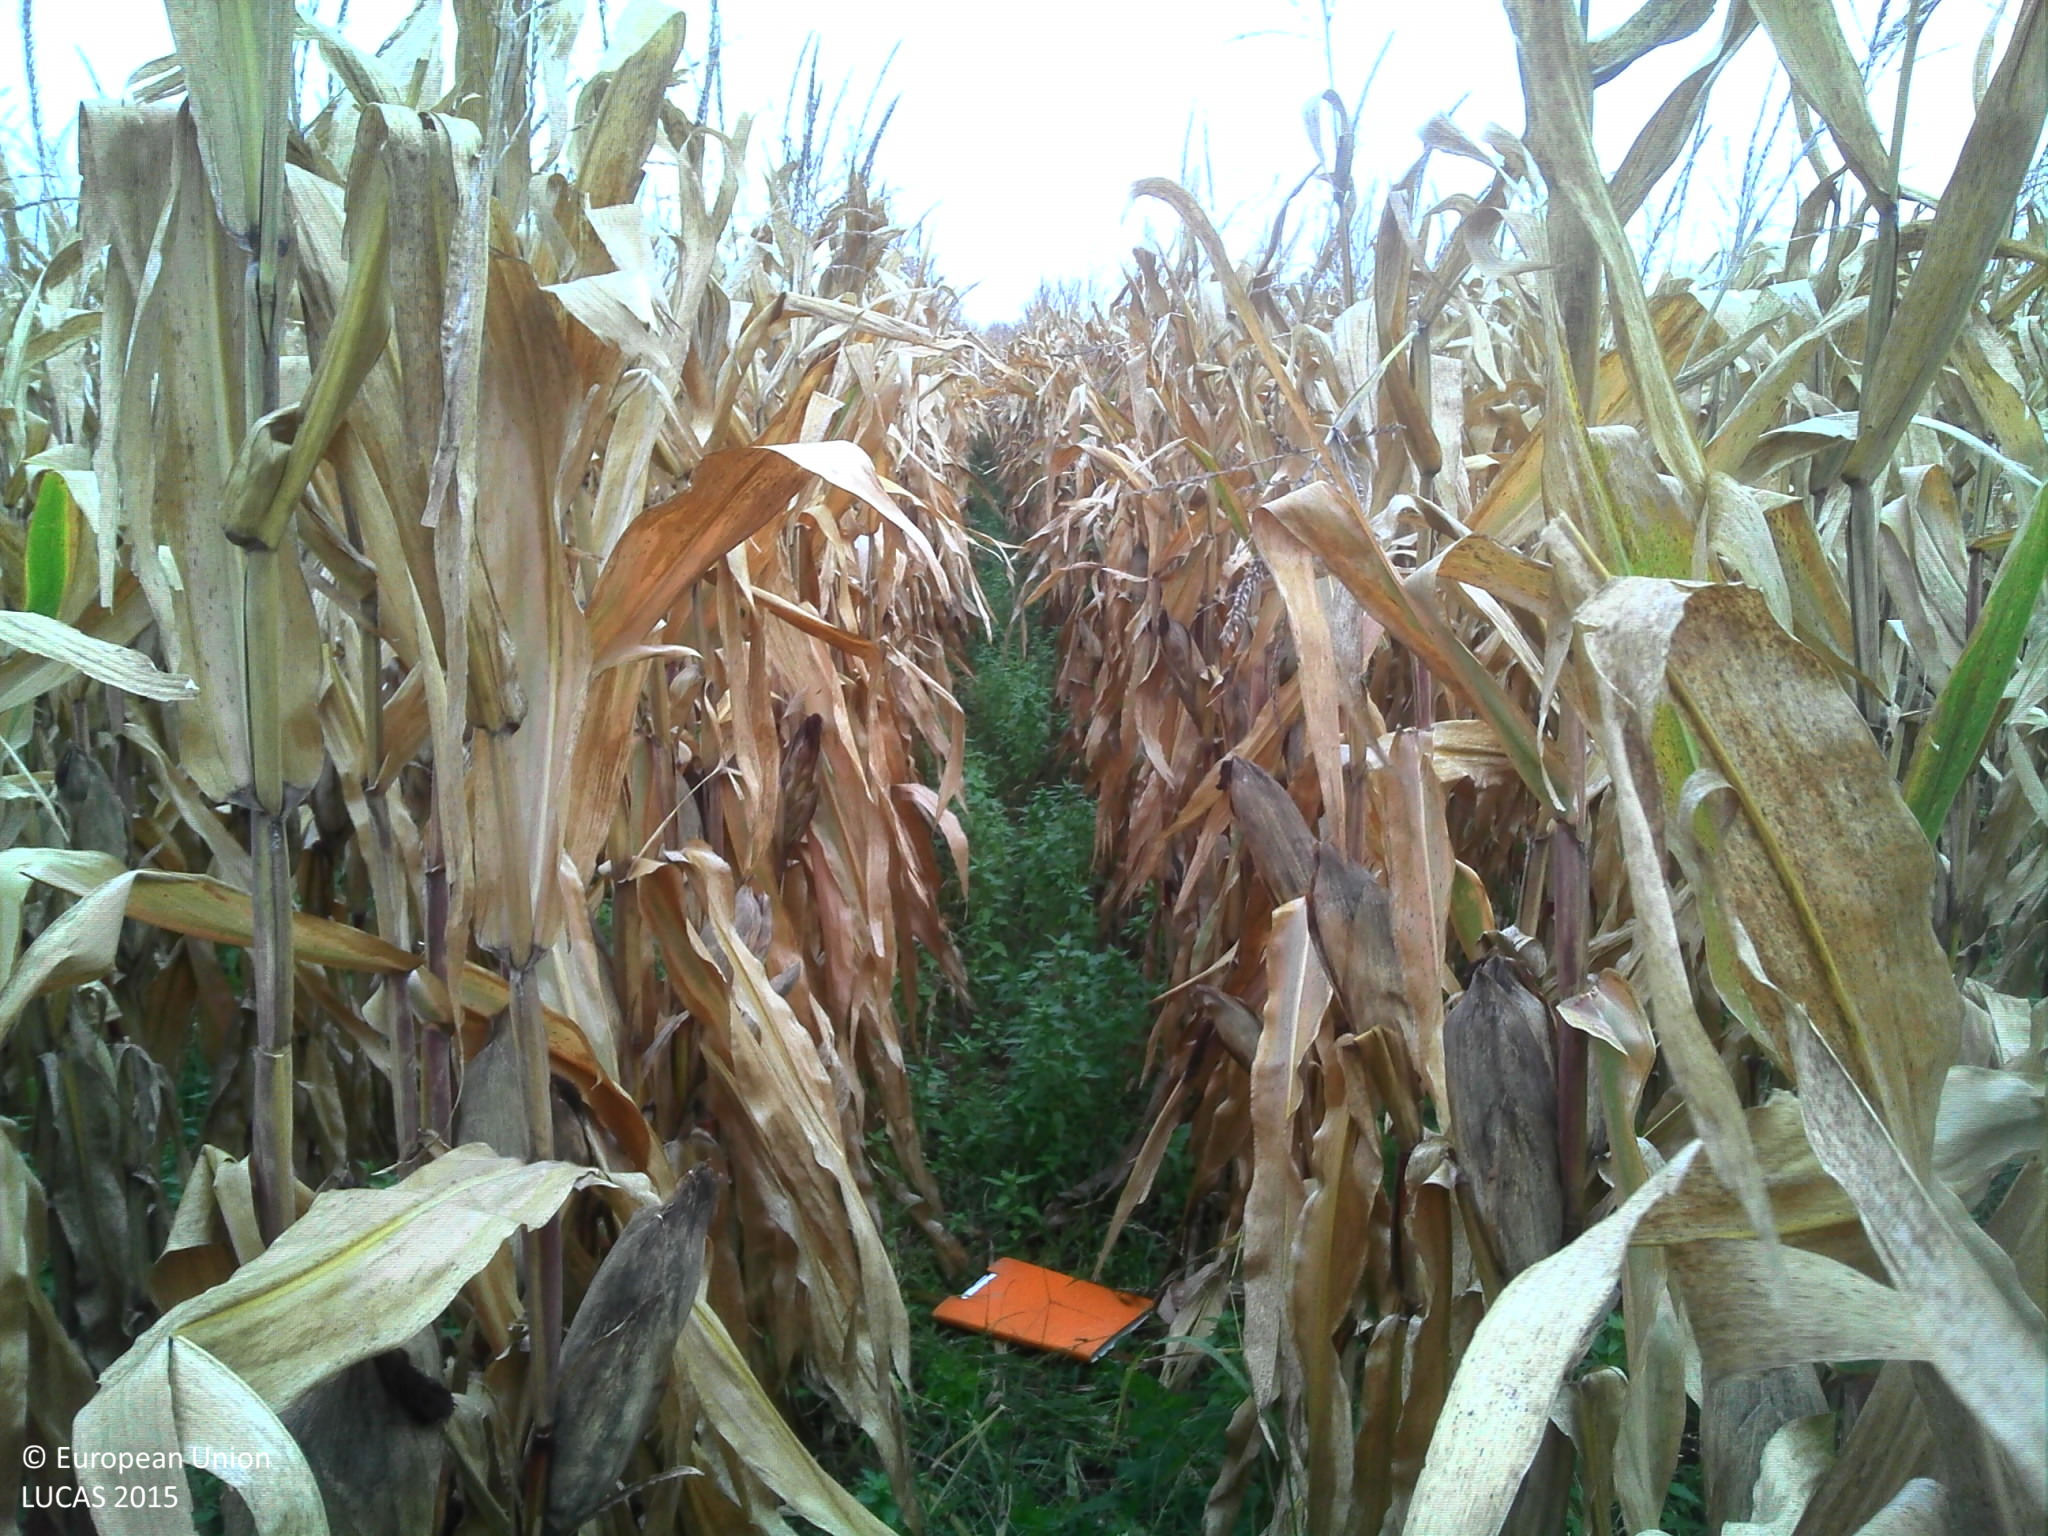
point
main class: Cropland
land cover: Maize
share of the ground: 25 - 50 %
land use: Agriculture (excluding fallow land and kitchen gardens)
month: October
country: FR
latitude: 46.4536
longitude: -1.0069
